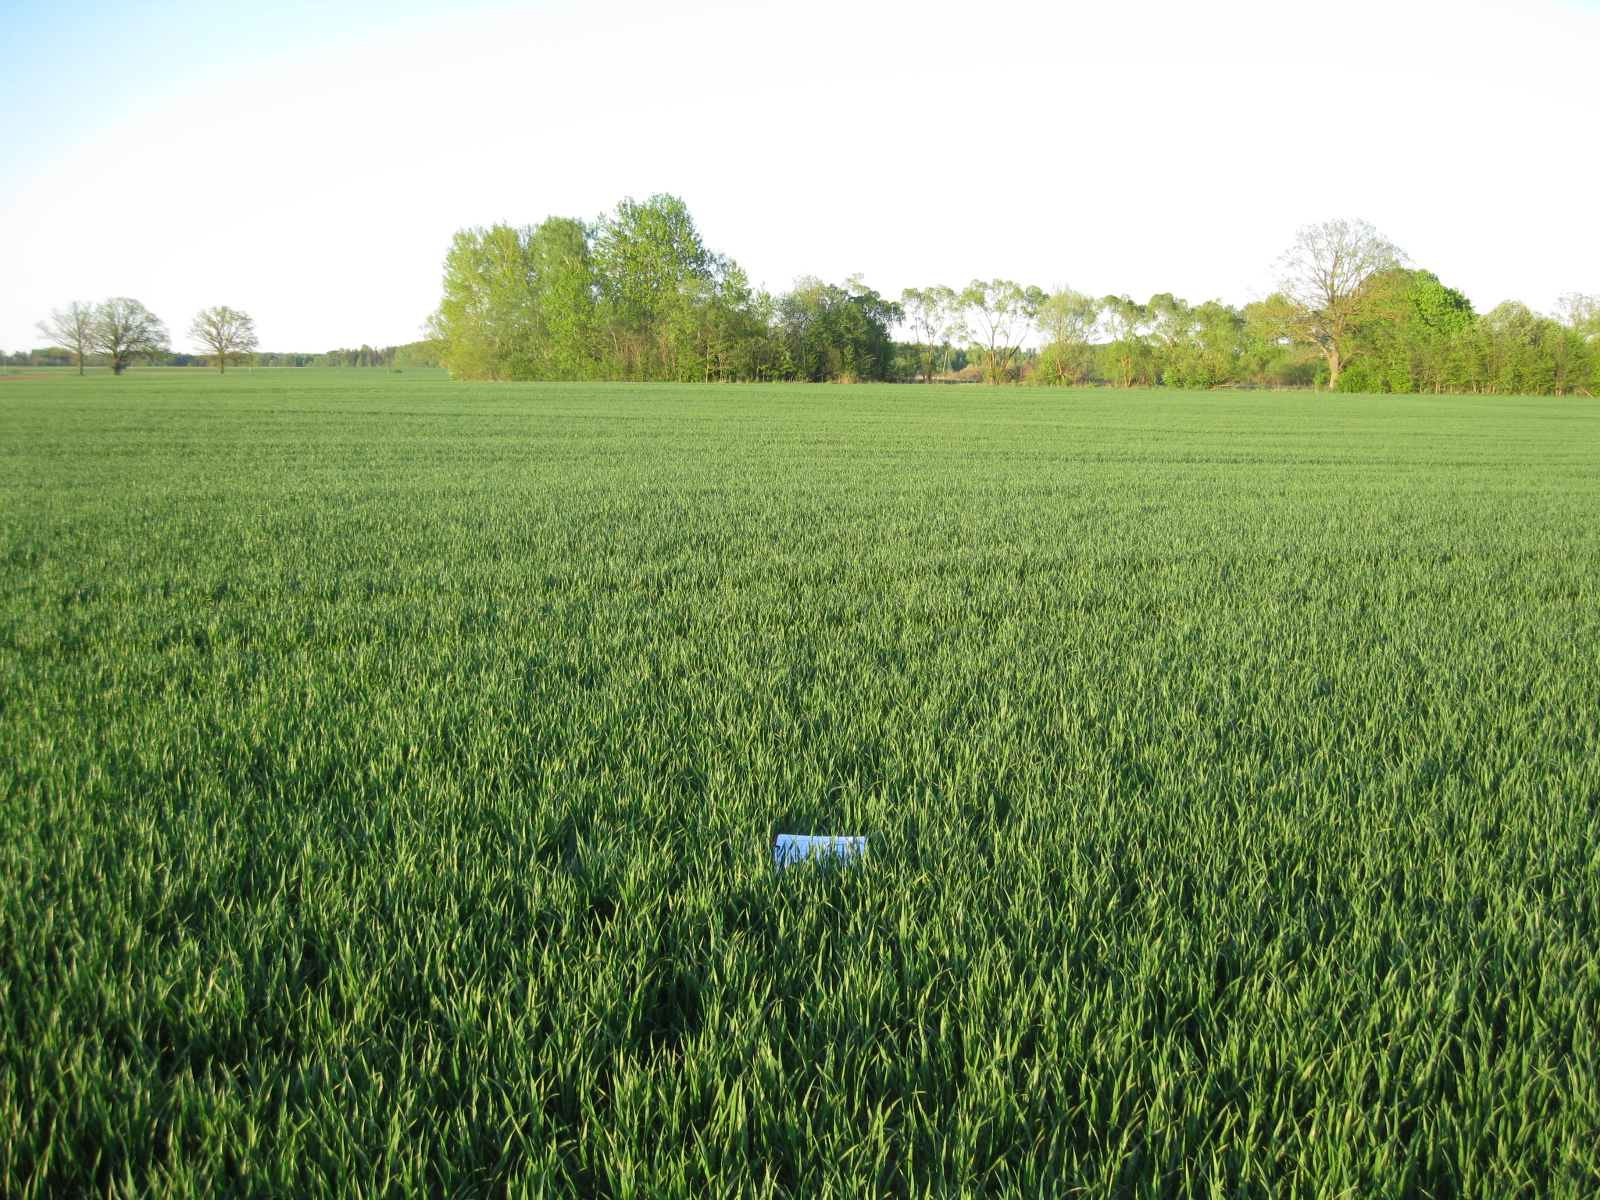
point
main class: Cropland
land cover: Common wheat
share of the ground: > 75 %
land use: Agriculture (excluding fallow land and kitchen gardens)
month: May
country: LT
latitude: 56.0993
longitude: 24.4197
